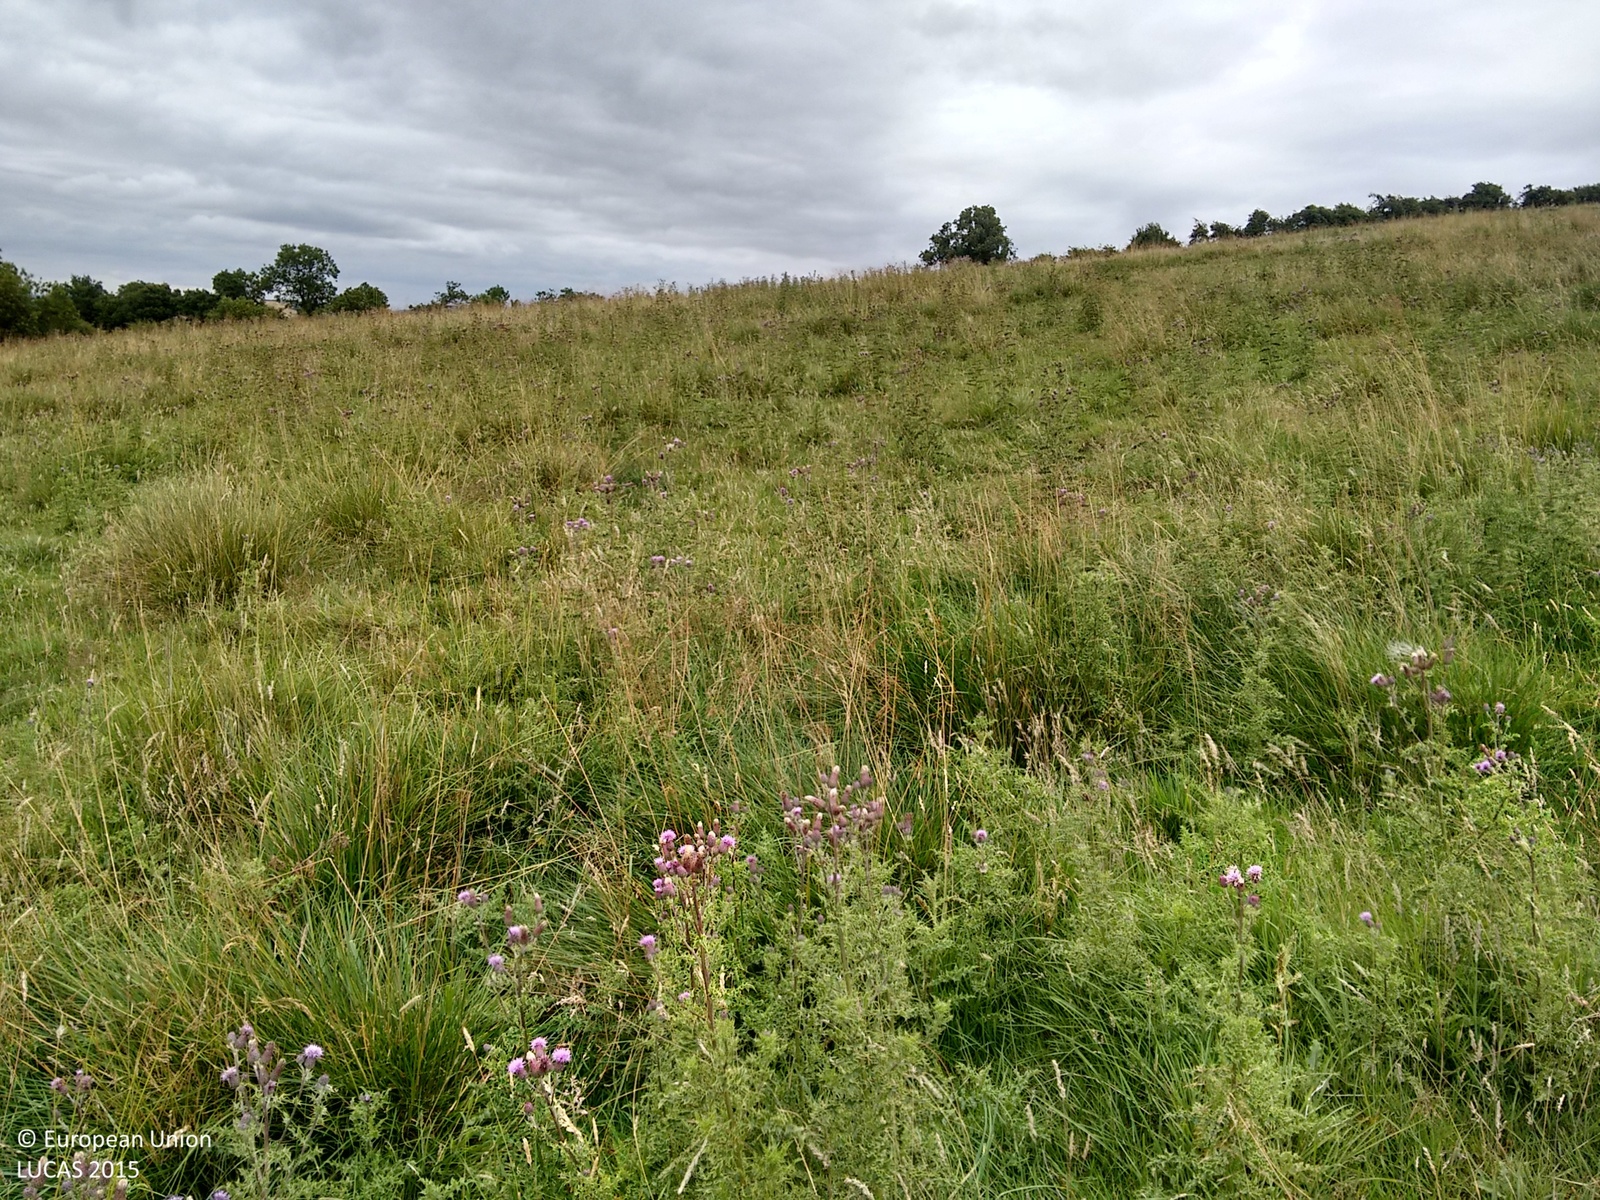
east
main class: Grassland
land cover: Grassland without tree/shrub cover
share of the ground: > 75 %
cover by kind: herbaceous plants 100 %
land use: Agriculture (excluding fallow land and kitchen gardens)
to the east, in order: Grassland without tree/shrub cover; Managed hedges; Fences; Grassland without tree/shrub cover
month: July
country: GB
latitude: 52.8105
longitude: -0.9776
